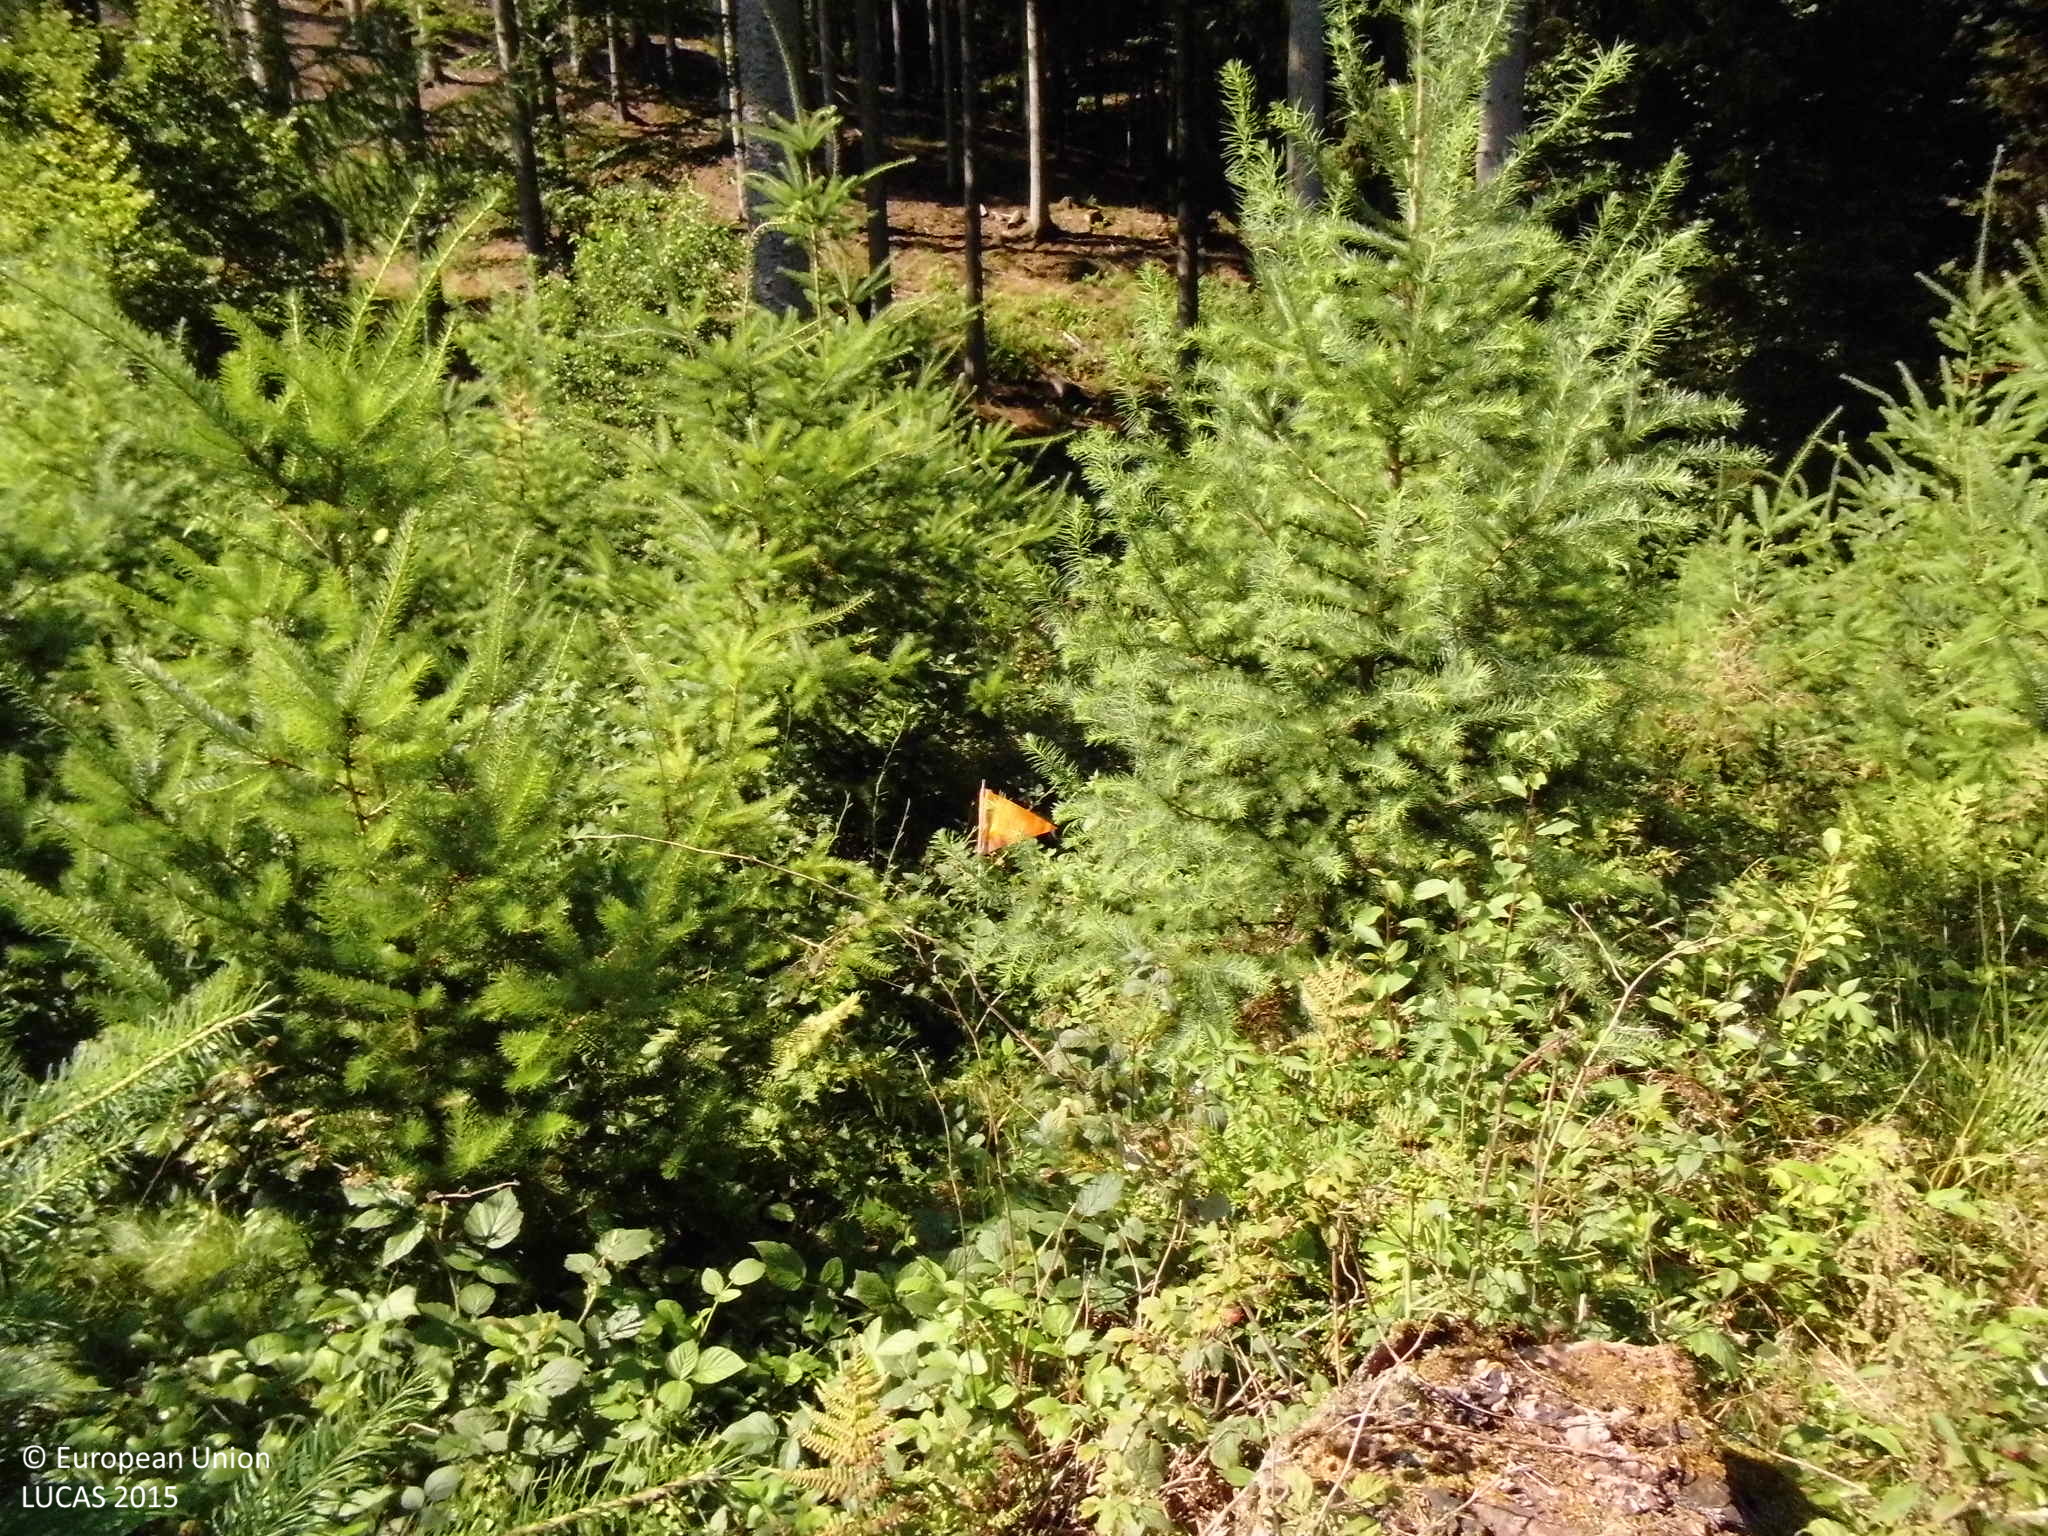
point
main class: Woodland
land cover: Other coniferous woodland
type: hemiboreal forest and nemoral coniferous forest and mixed broadleaved-coniferous forest
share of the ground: 25 - 50 %
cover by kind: coniferous forest trees 45 %, herbaceous plants 25 %, broadleaved forest trees 15 %, shrubs 15 %
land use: Forestry
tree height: < 5 m
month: August
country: DE
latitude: 51.1556
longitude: 7.9844
